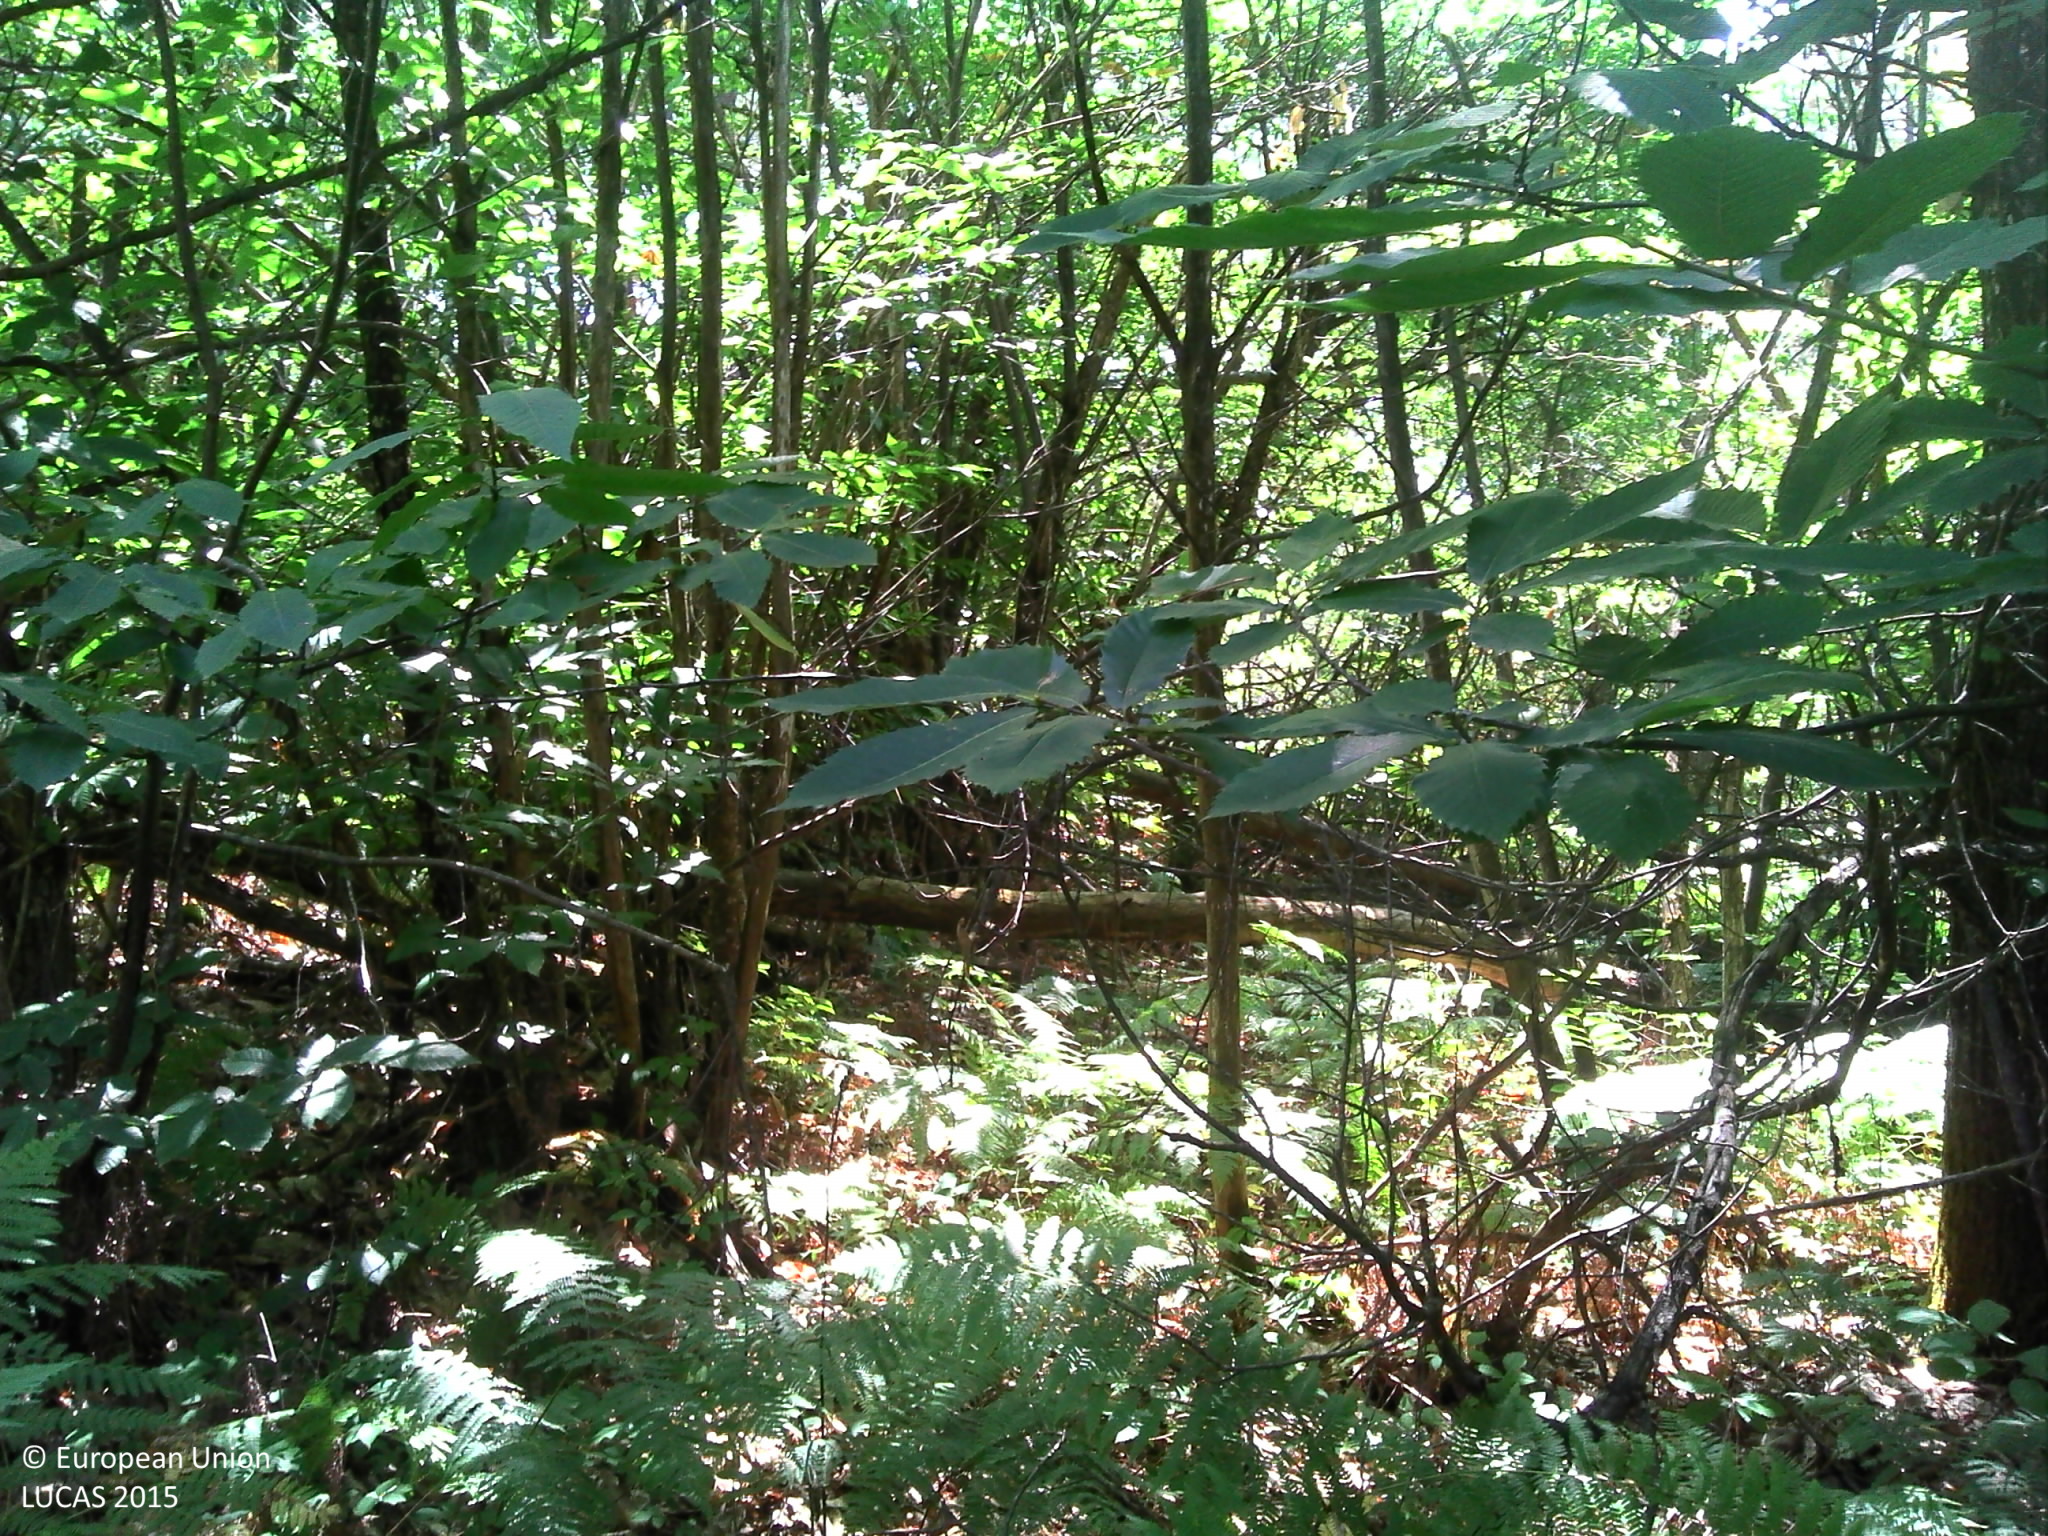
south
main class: Woodland
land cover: Pine dominated mixed woodland
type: mesophytic deciduous forest
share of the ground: > 75 %
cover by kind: broadleaved forest trees 50 %, coniferous forest trees 20 %, herbaceous plants 20 %, shrubs 5 %
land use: Forestry
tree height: > 5 m
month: August
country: FR
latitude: 45.2273
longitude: 0.7820
